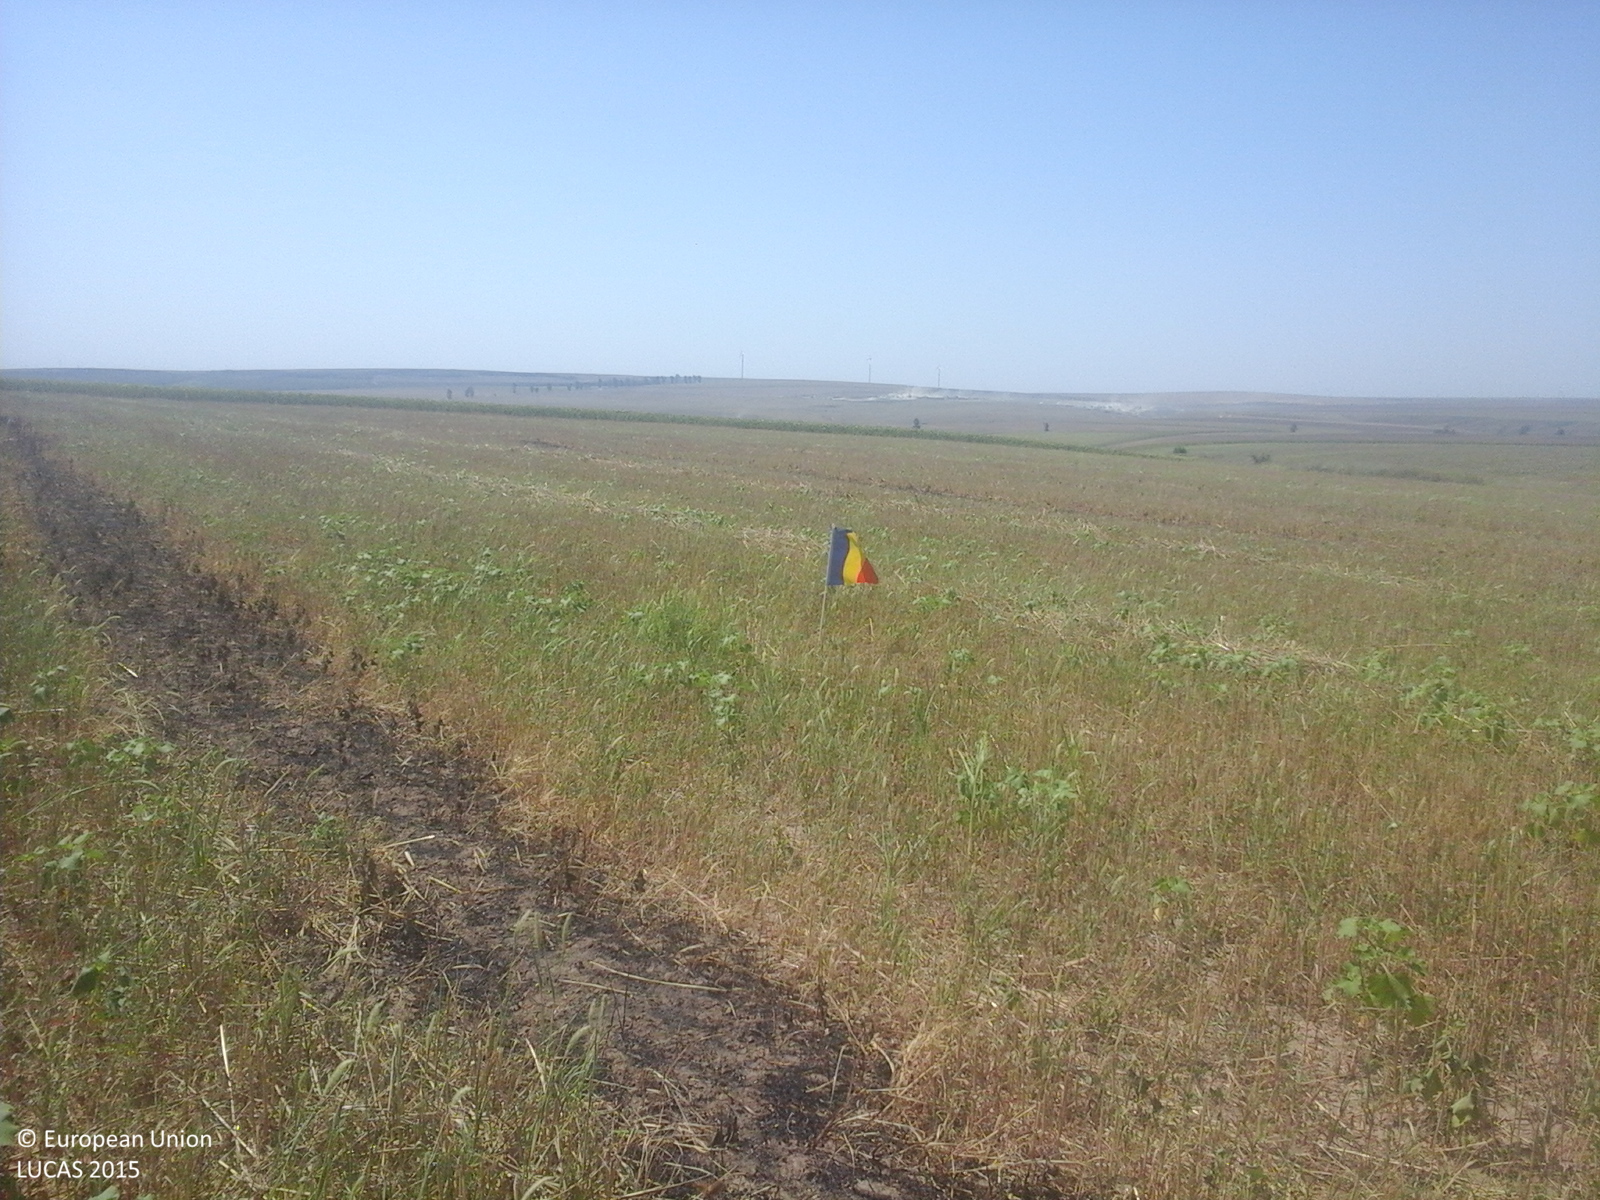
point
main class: Cropland
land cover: Common wheat
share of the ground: > 75 %
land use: Agriculture (excluding fallow land and kitchen gardens)
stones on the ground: < 10 %
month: August
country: RO
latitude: 44.6202
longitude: 28.3304
